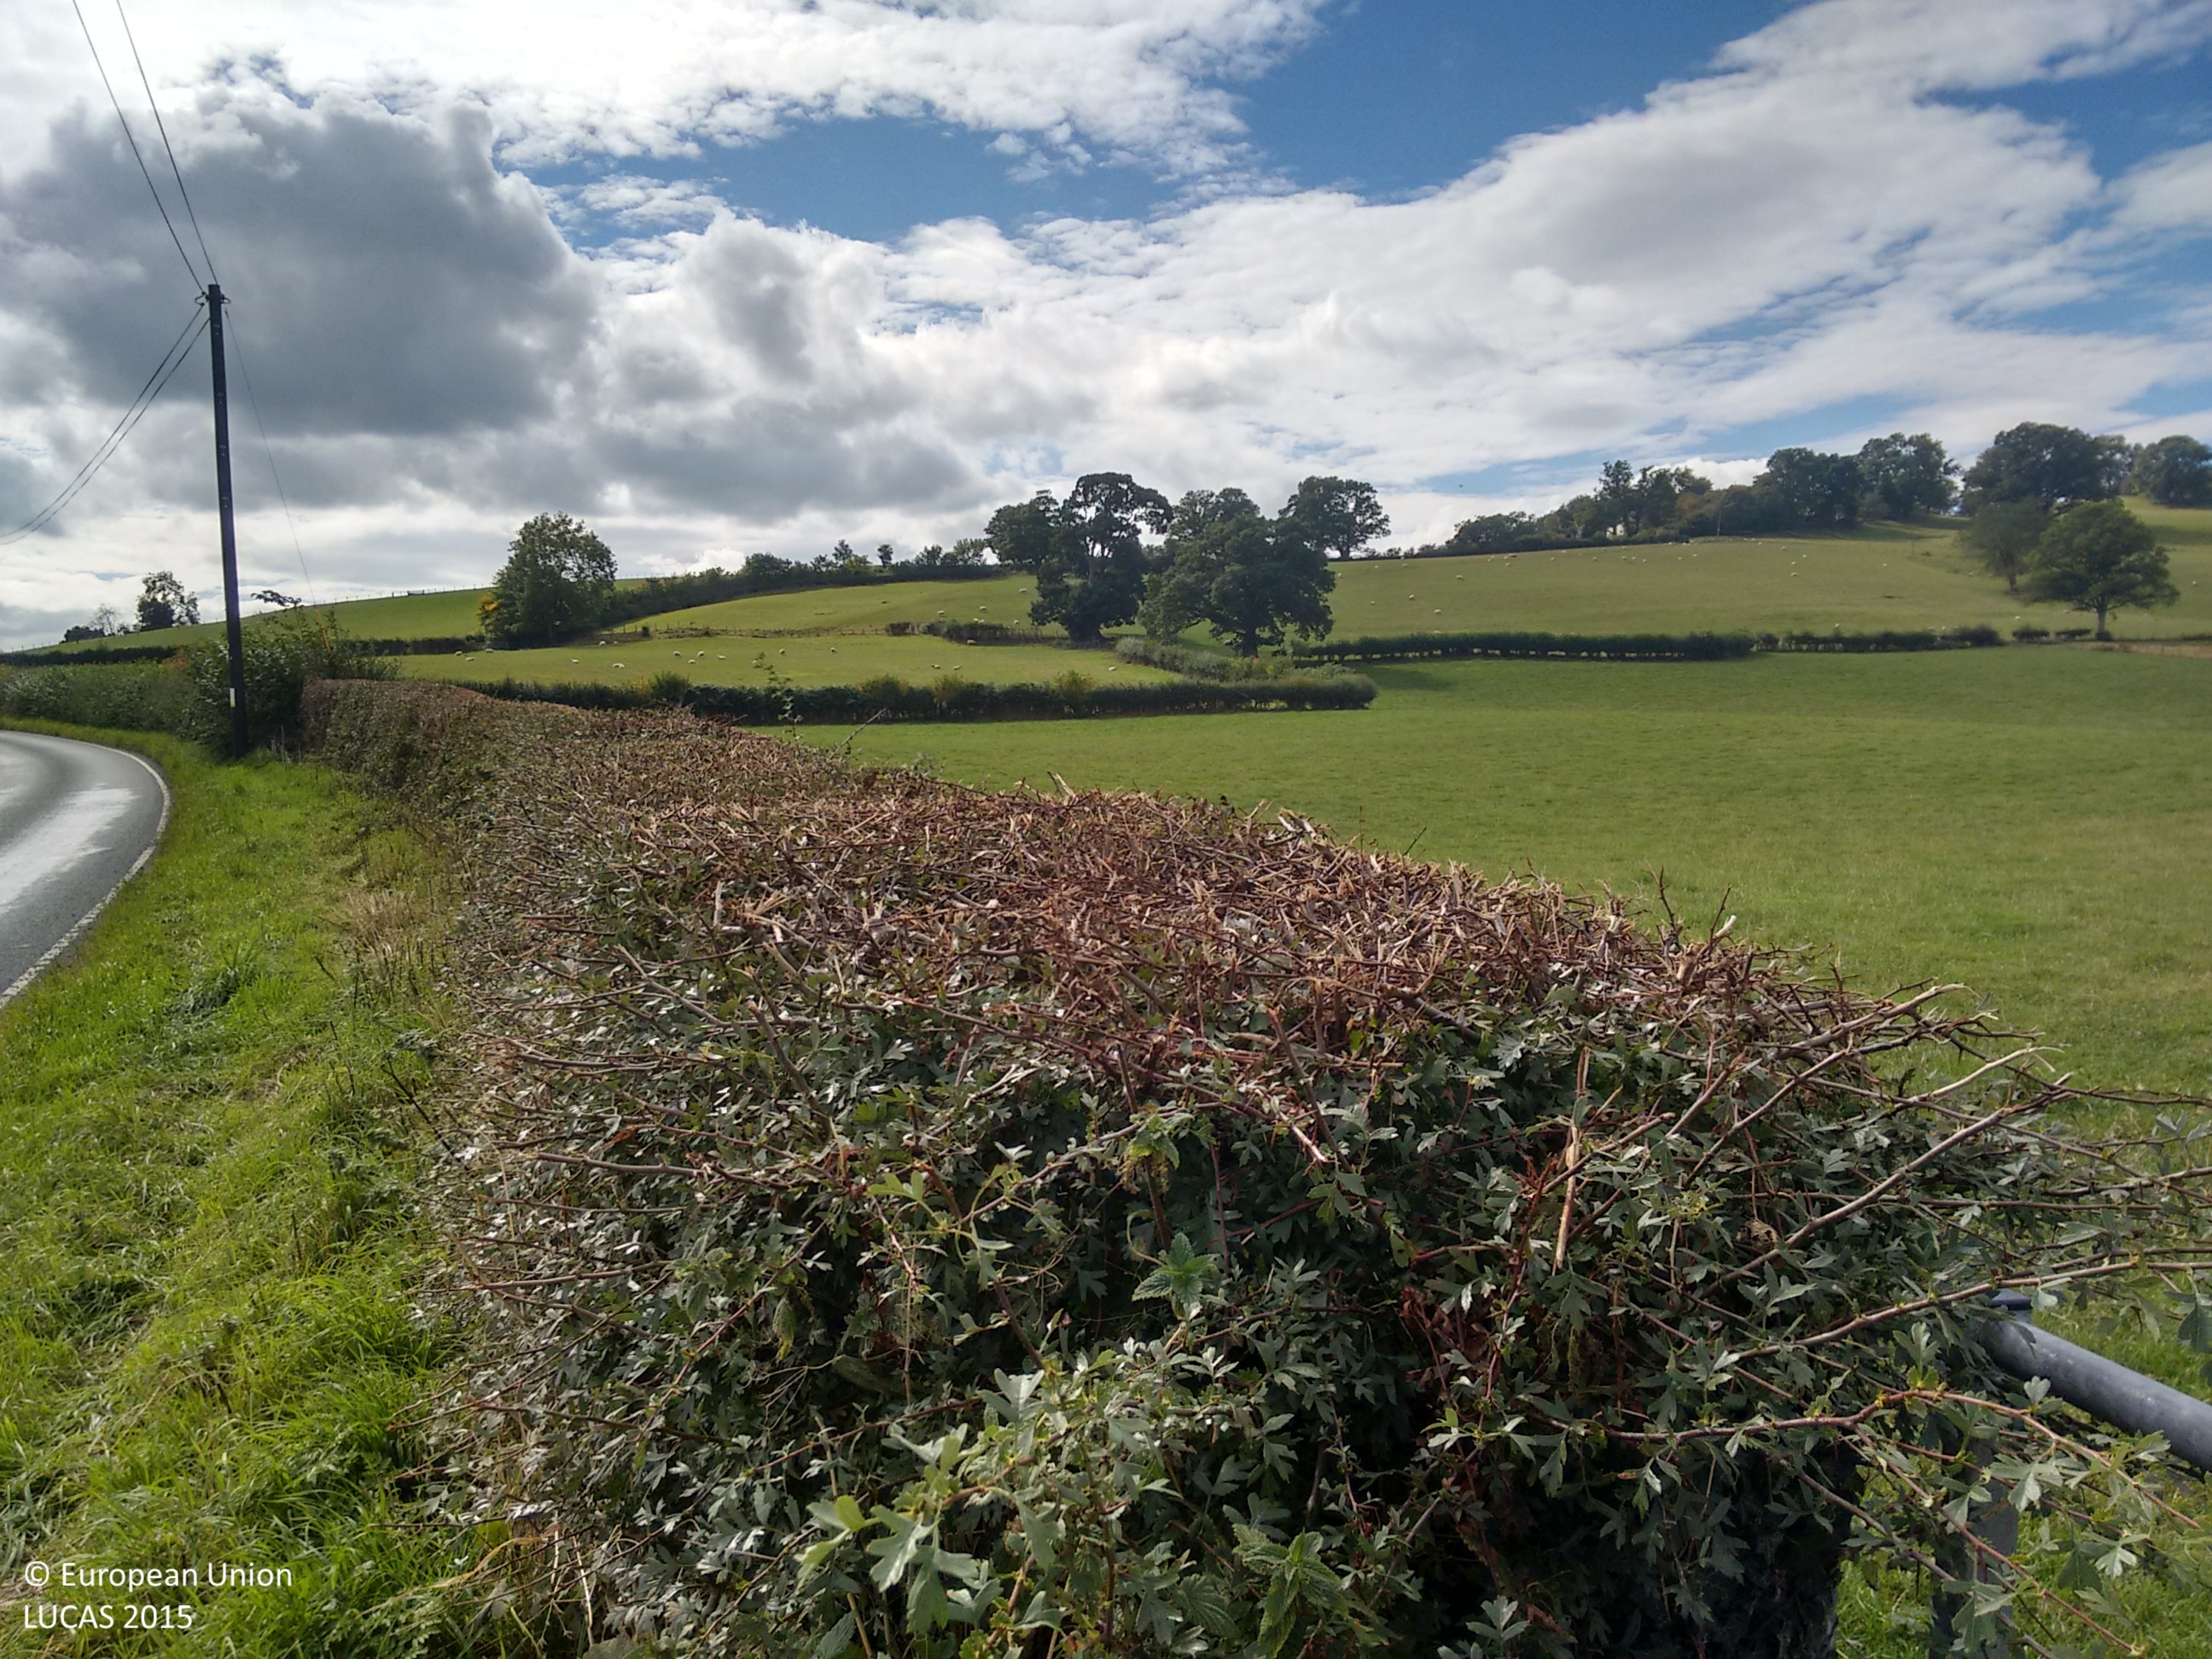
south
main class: Grassland
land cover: Grassland without tree/shrub cover
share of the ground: > 75 %
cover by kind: herbaceous plants 100 %
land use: Agriculture (excluding fallow land and kitchen gardens)
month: September
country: GB
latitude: 52.7701
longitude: -3.1656
